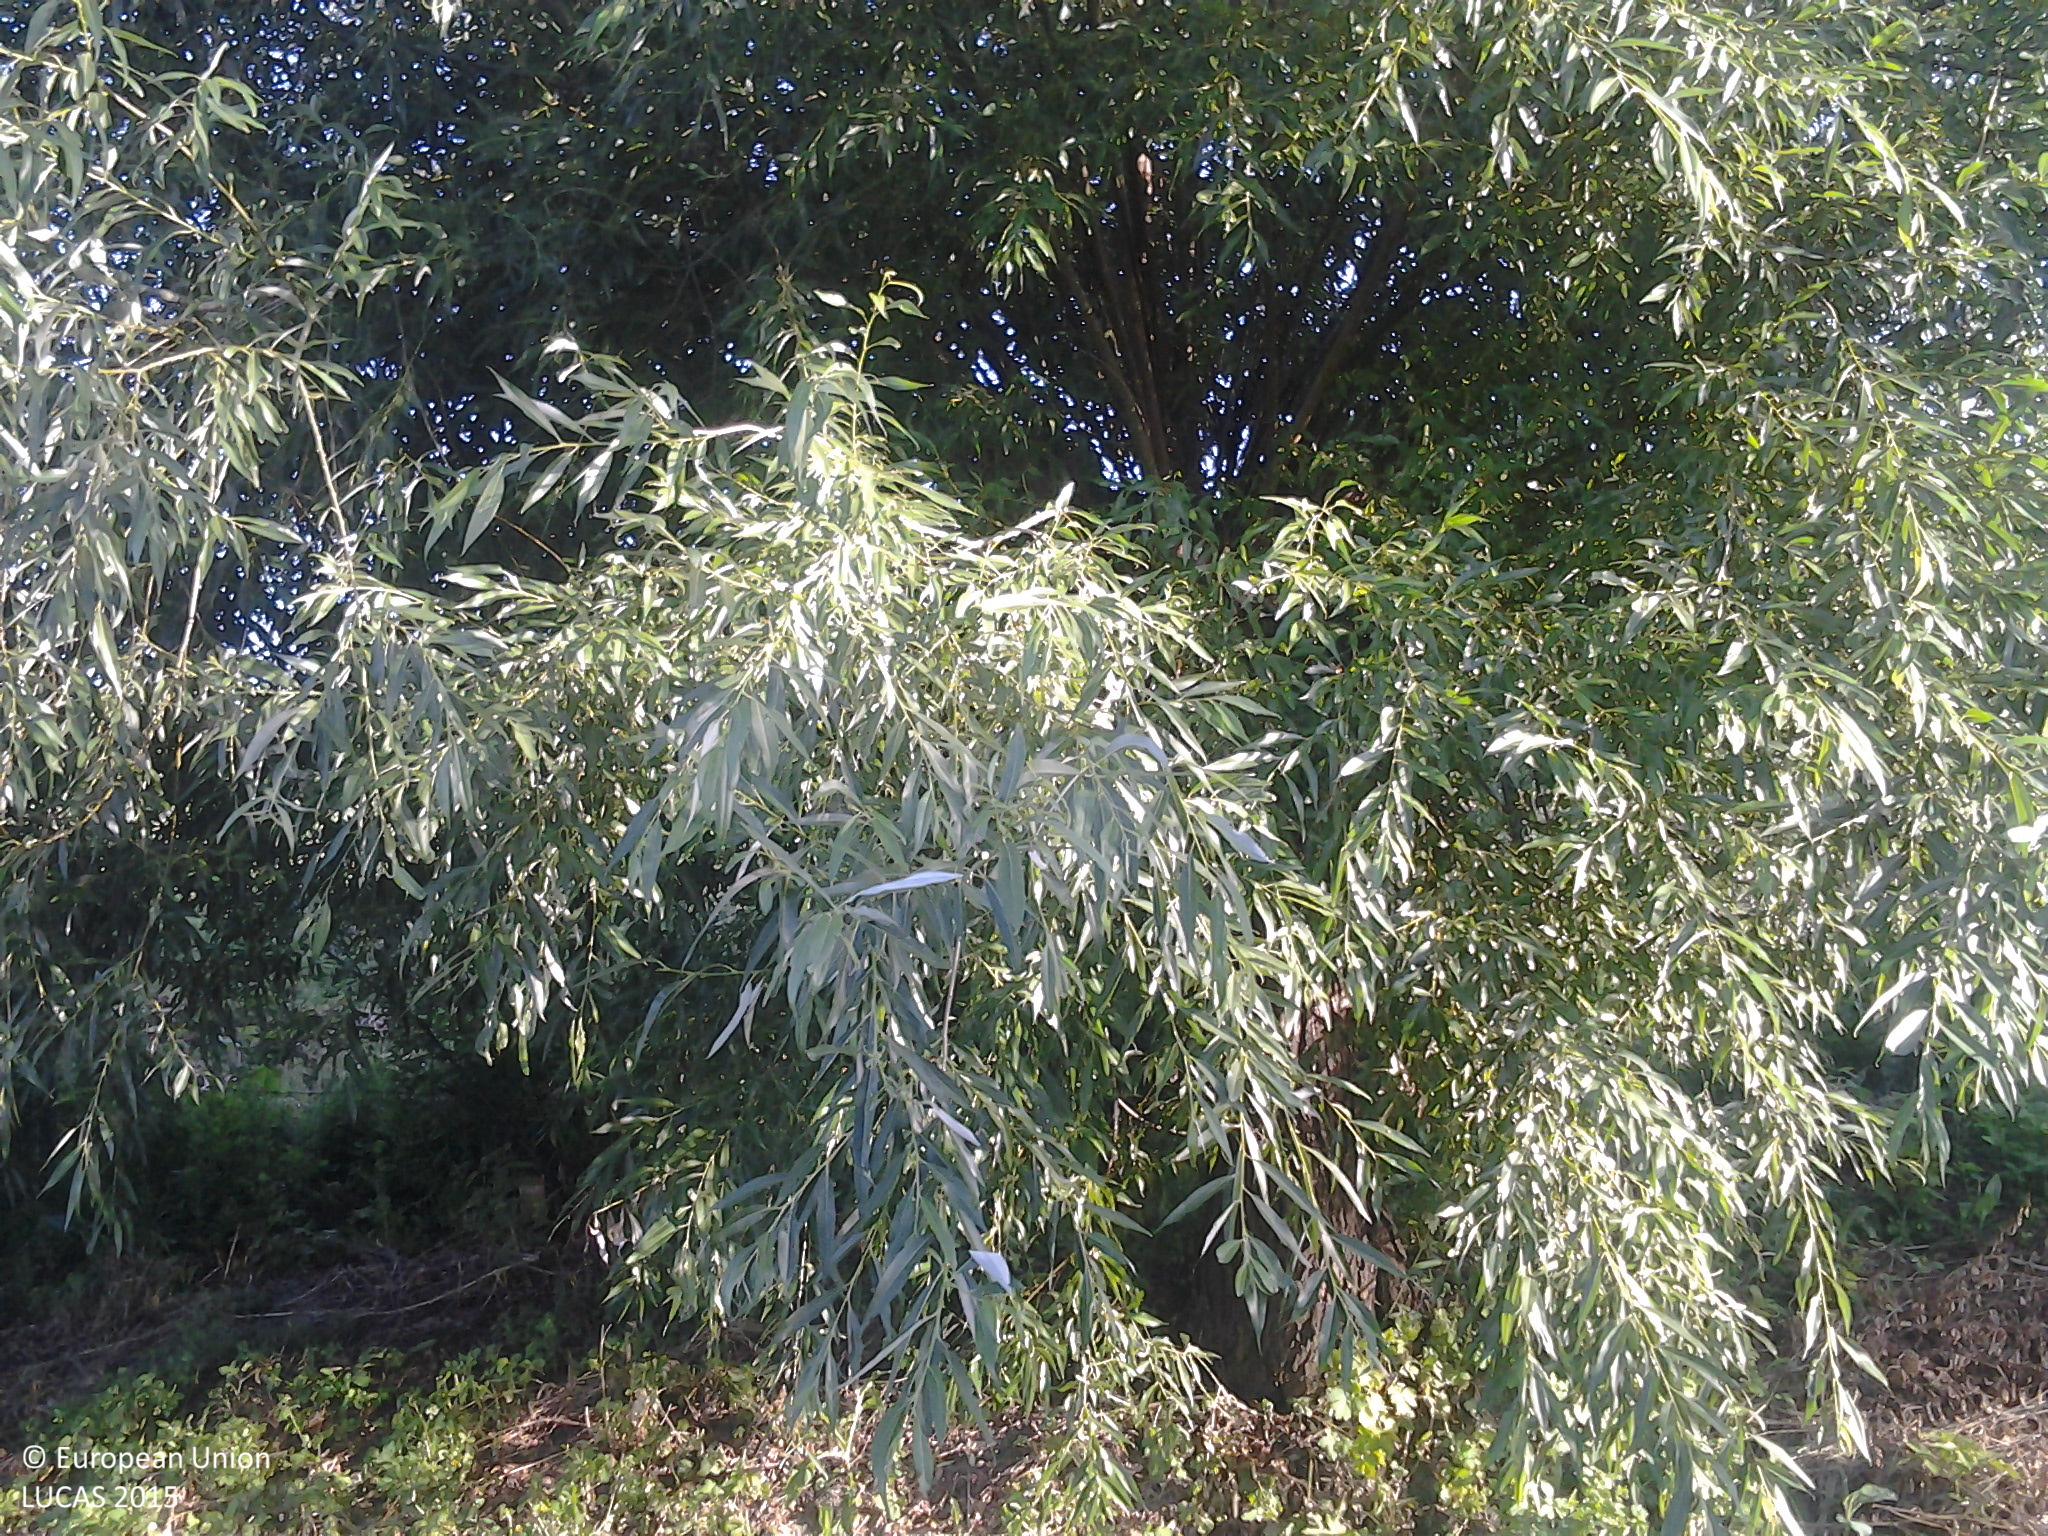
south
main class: Grassland
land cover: Grassland with sparse tree/shrub cover
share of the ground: > 75 %
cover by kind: herbaceous plants 90 %, broadleaved forest trees 5 %, shrubs 5 %
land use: Agriculture (excluding fallow land and kitchen gardens)
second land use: Residential
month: June
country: RO
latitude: 47.1998
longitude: 26.9022
